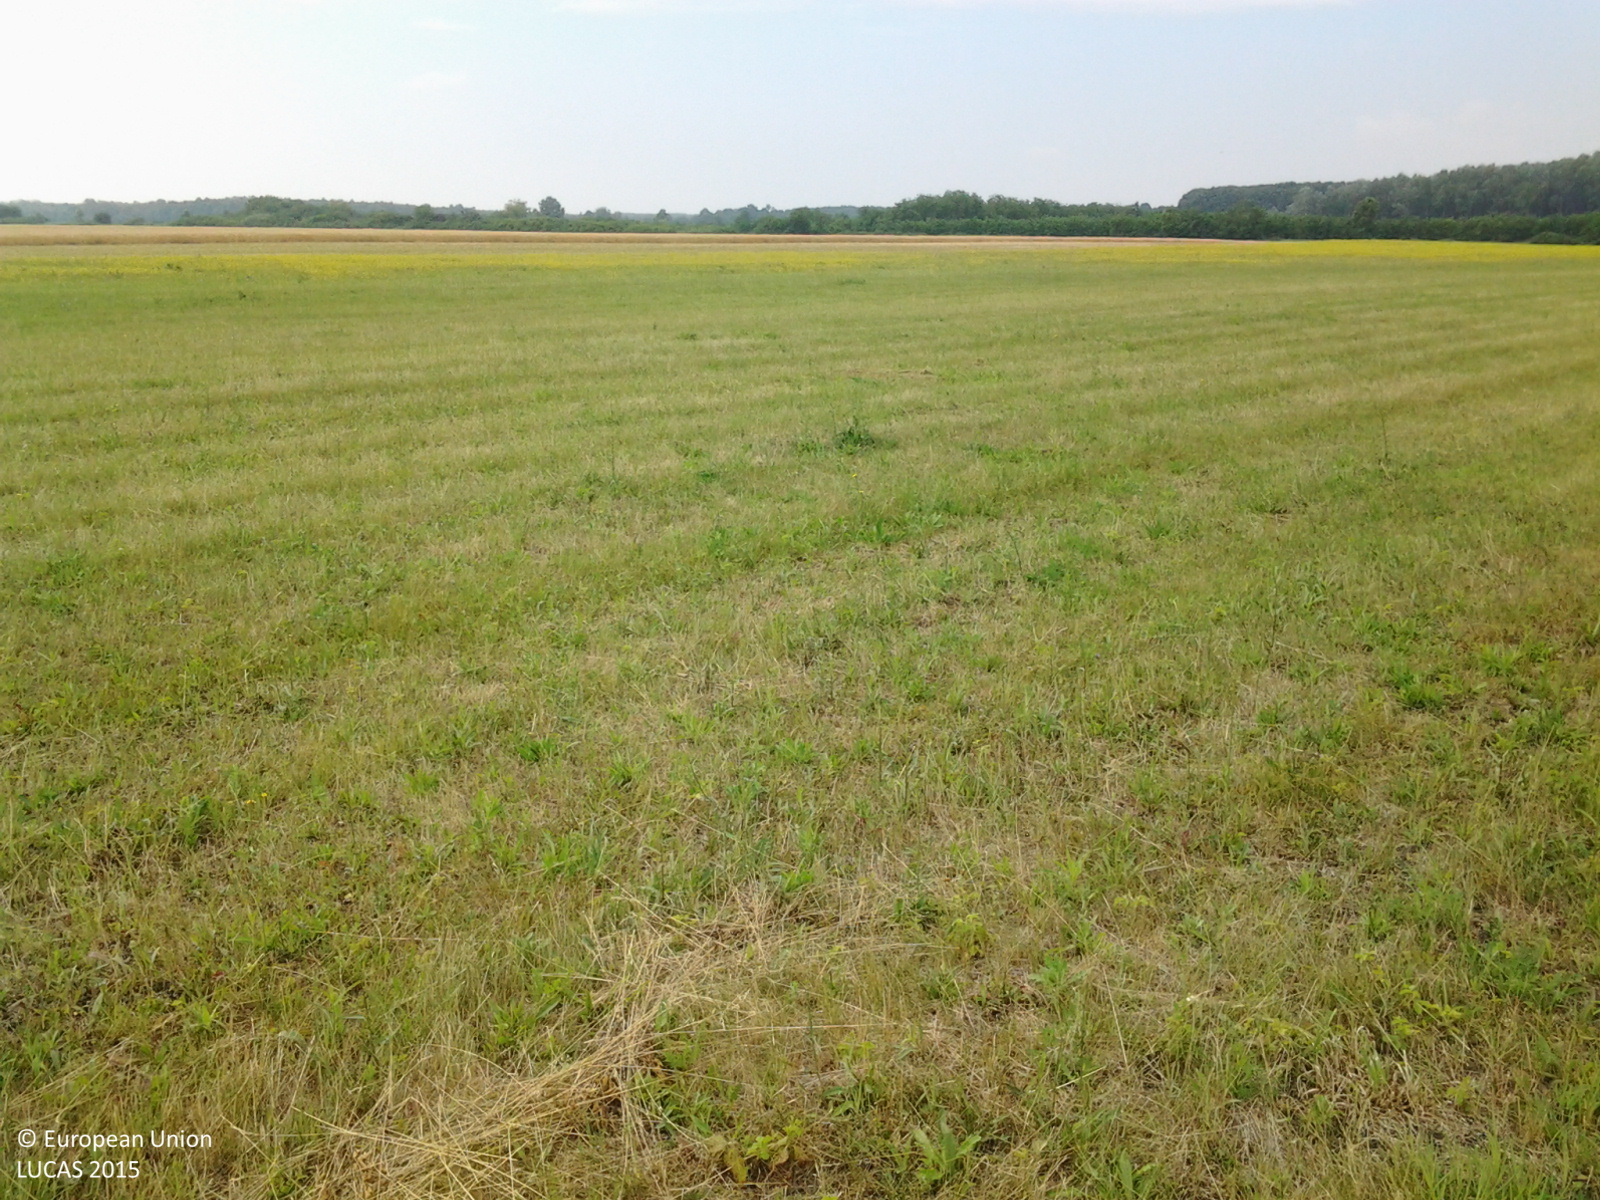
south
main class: Grassland
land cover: Grassland without tree/shrub cover
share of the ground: > 75 %
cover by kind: herbaceous plants 100 %
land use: Agriculture (excluding fallow land and kitchen gardens)
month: June
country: HU
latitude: 46.6864
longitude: 21.2144
